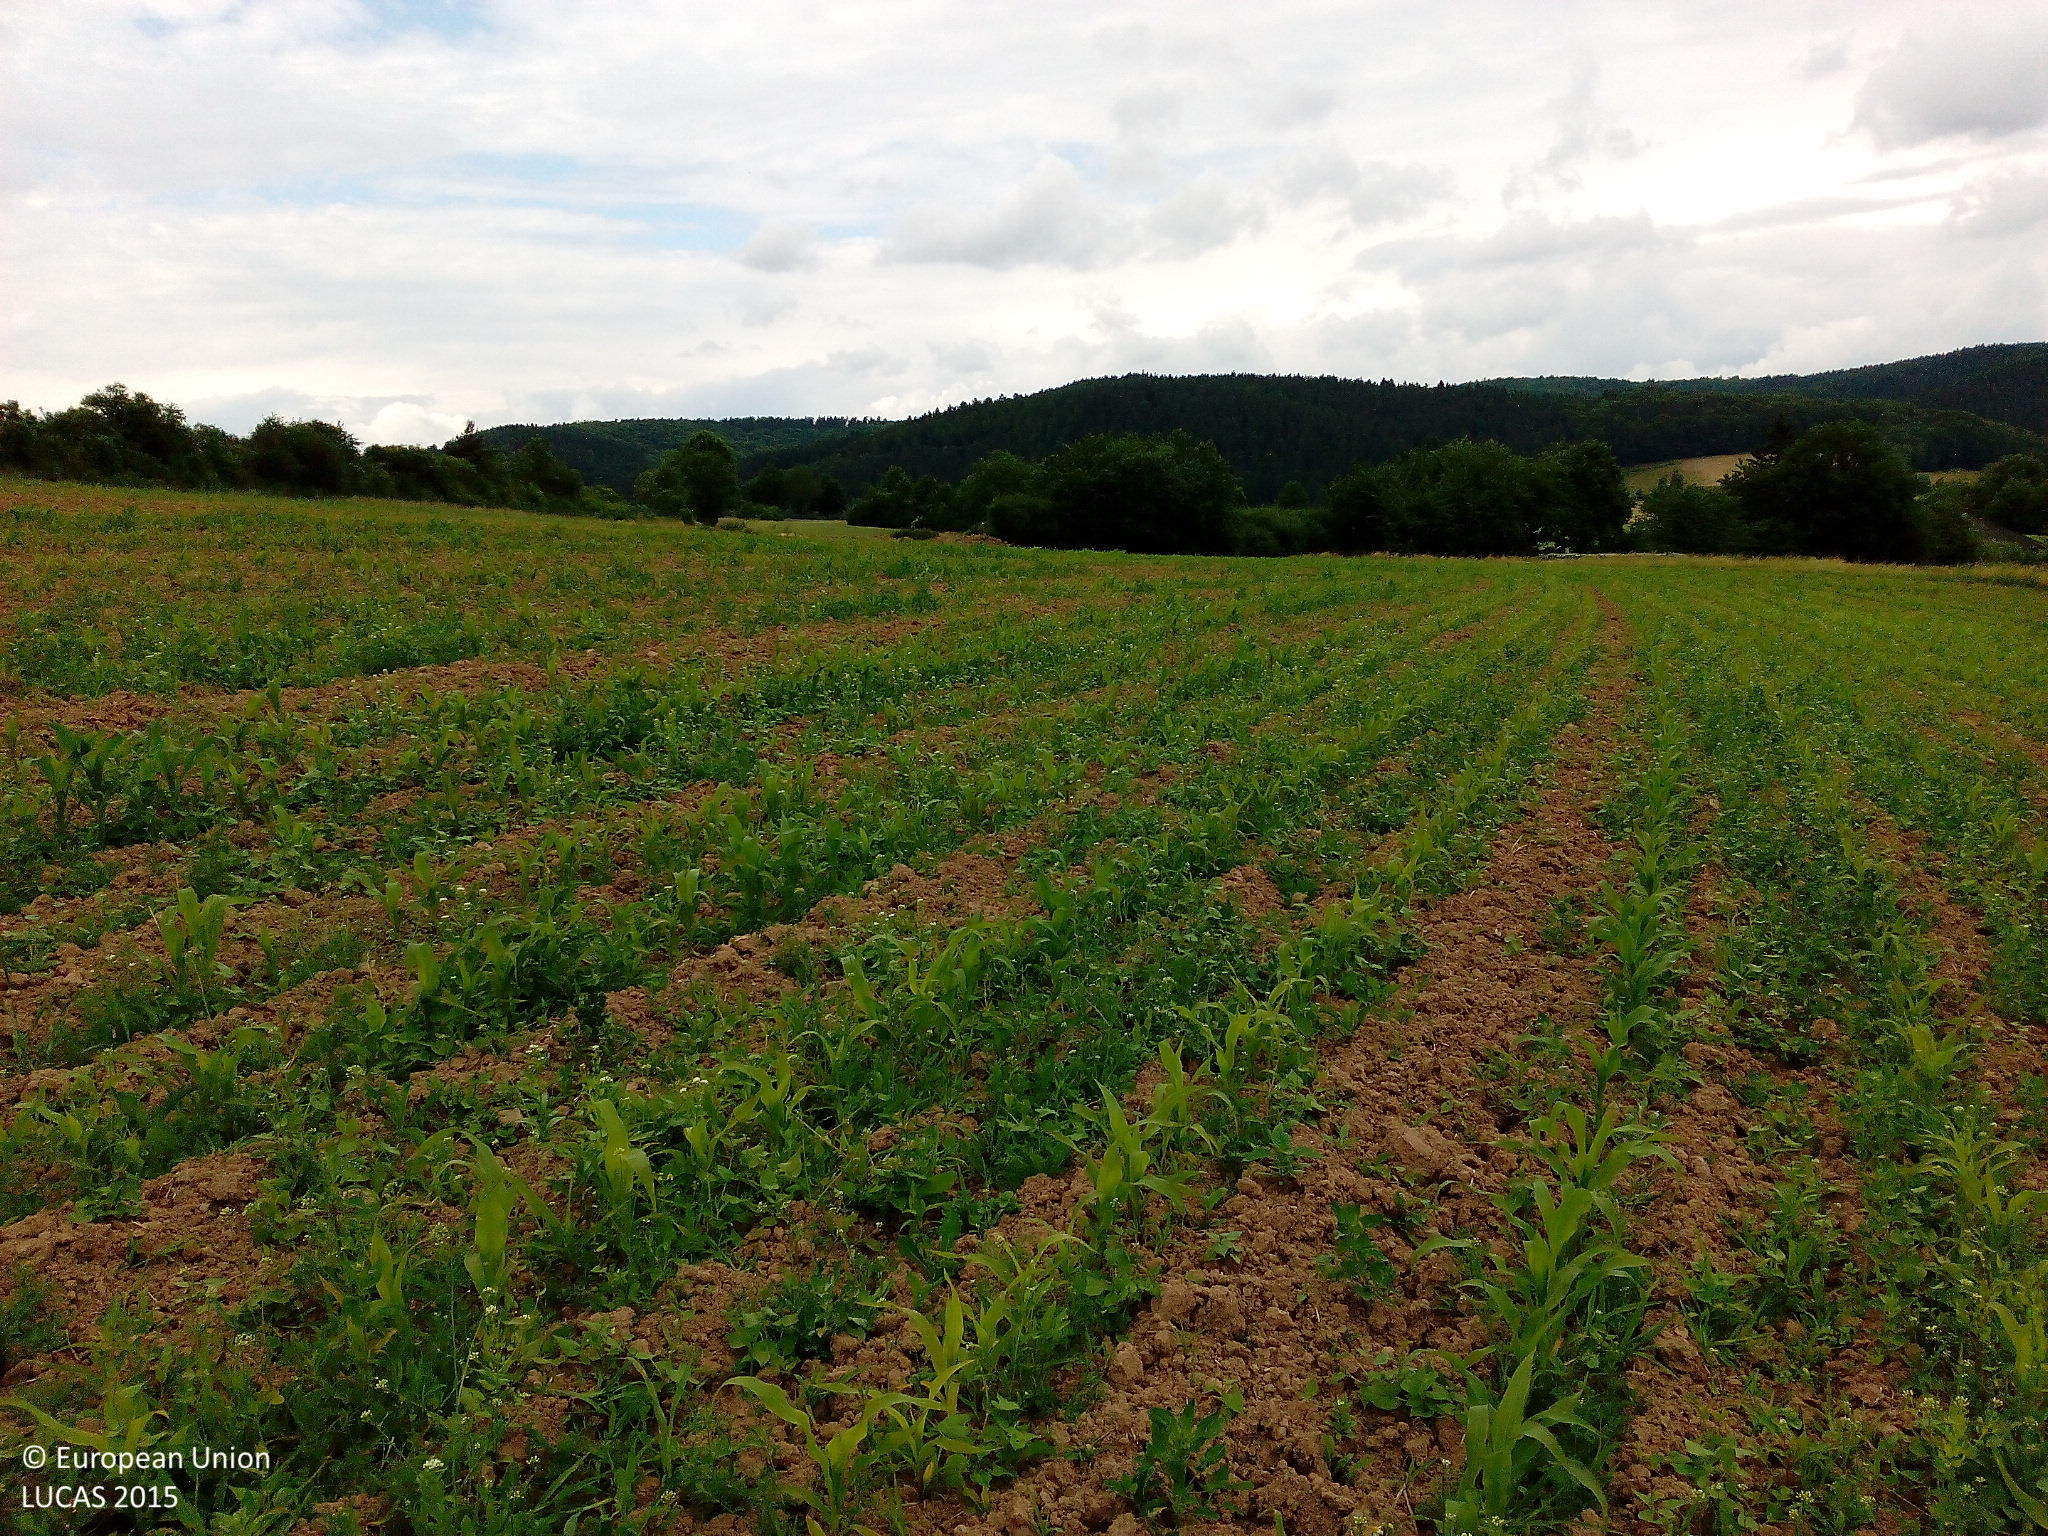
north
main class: Cropland
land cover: Maize
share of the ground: 25 - 50 %
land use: Agriculture (excluding fallow land and kitchen gardens)
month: June
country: DE
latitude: 50.9027
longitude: 9.5877
